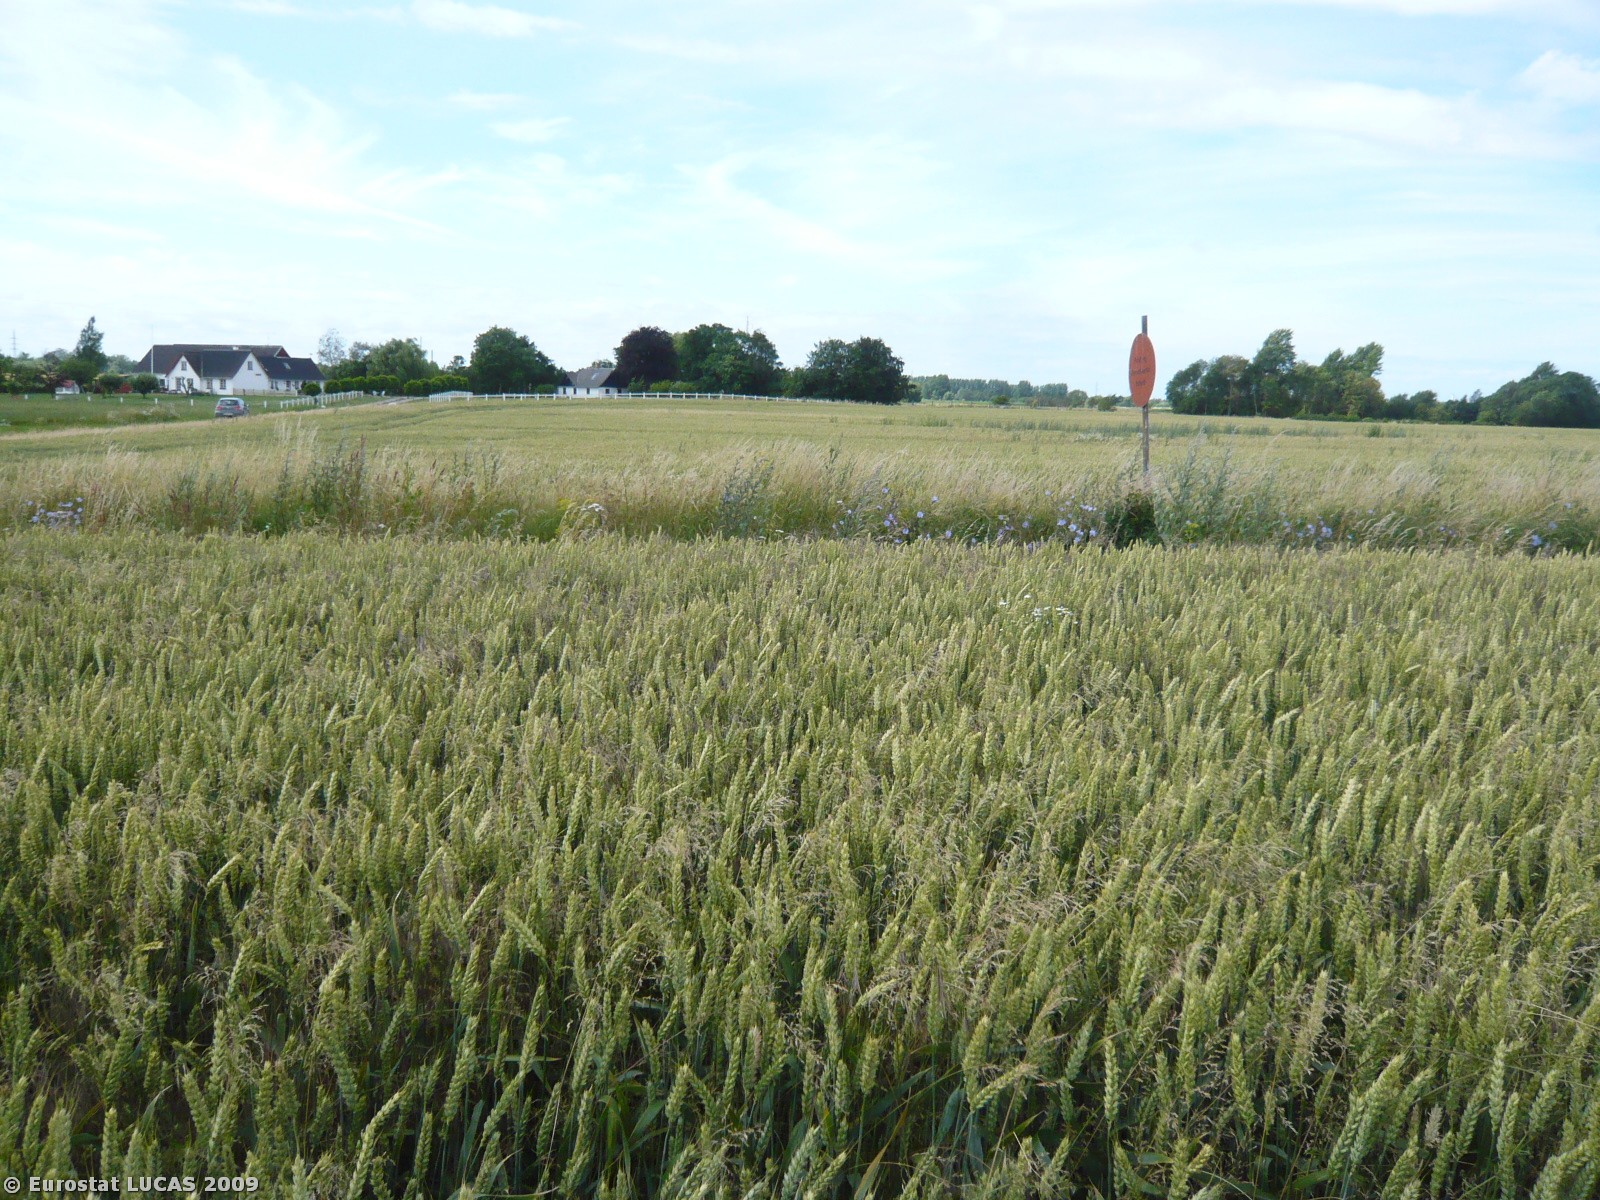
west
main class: Cropland
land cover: Common wheat
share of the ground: > 75 %
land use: Agriculture (excluding fallow land and kitchen gardens)
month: July
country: DK
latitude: 55.6612
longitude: 11.1593
